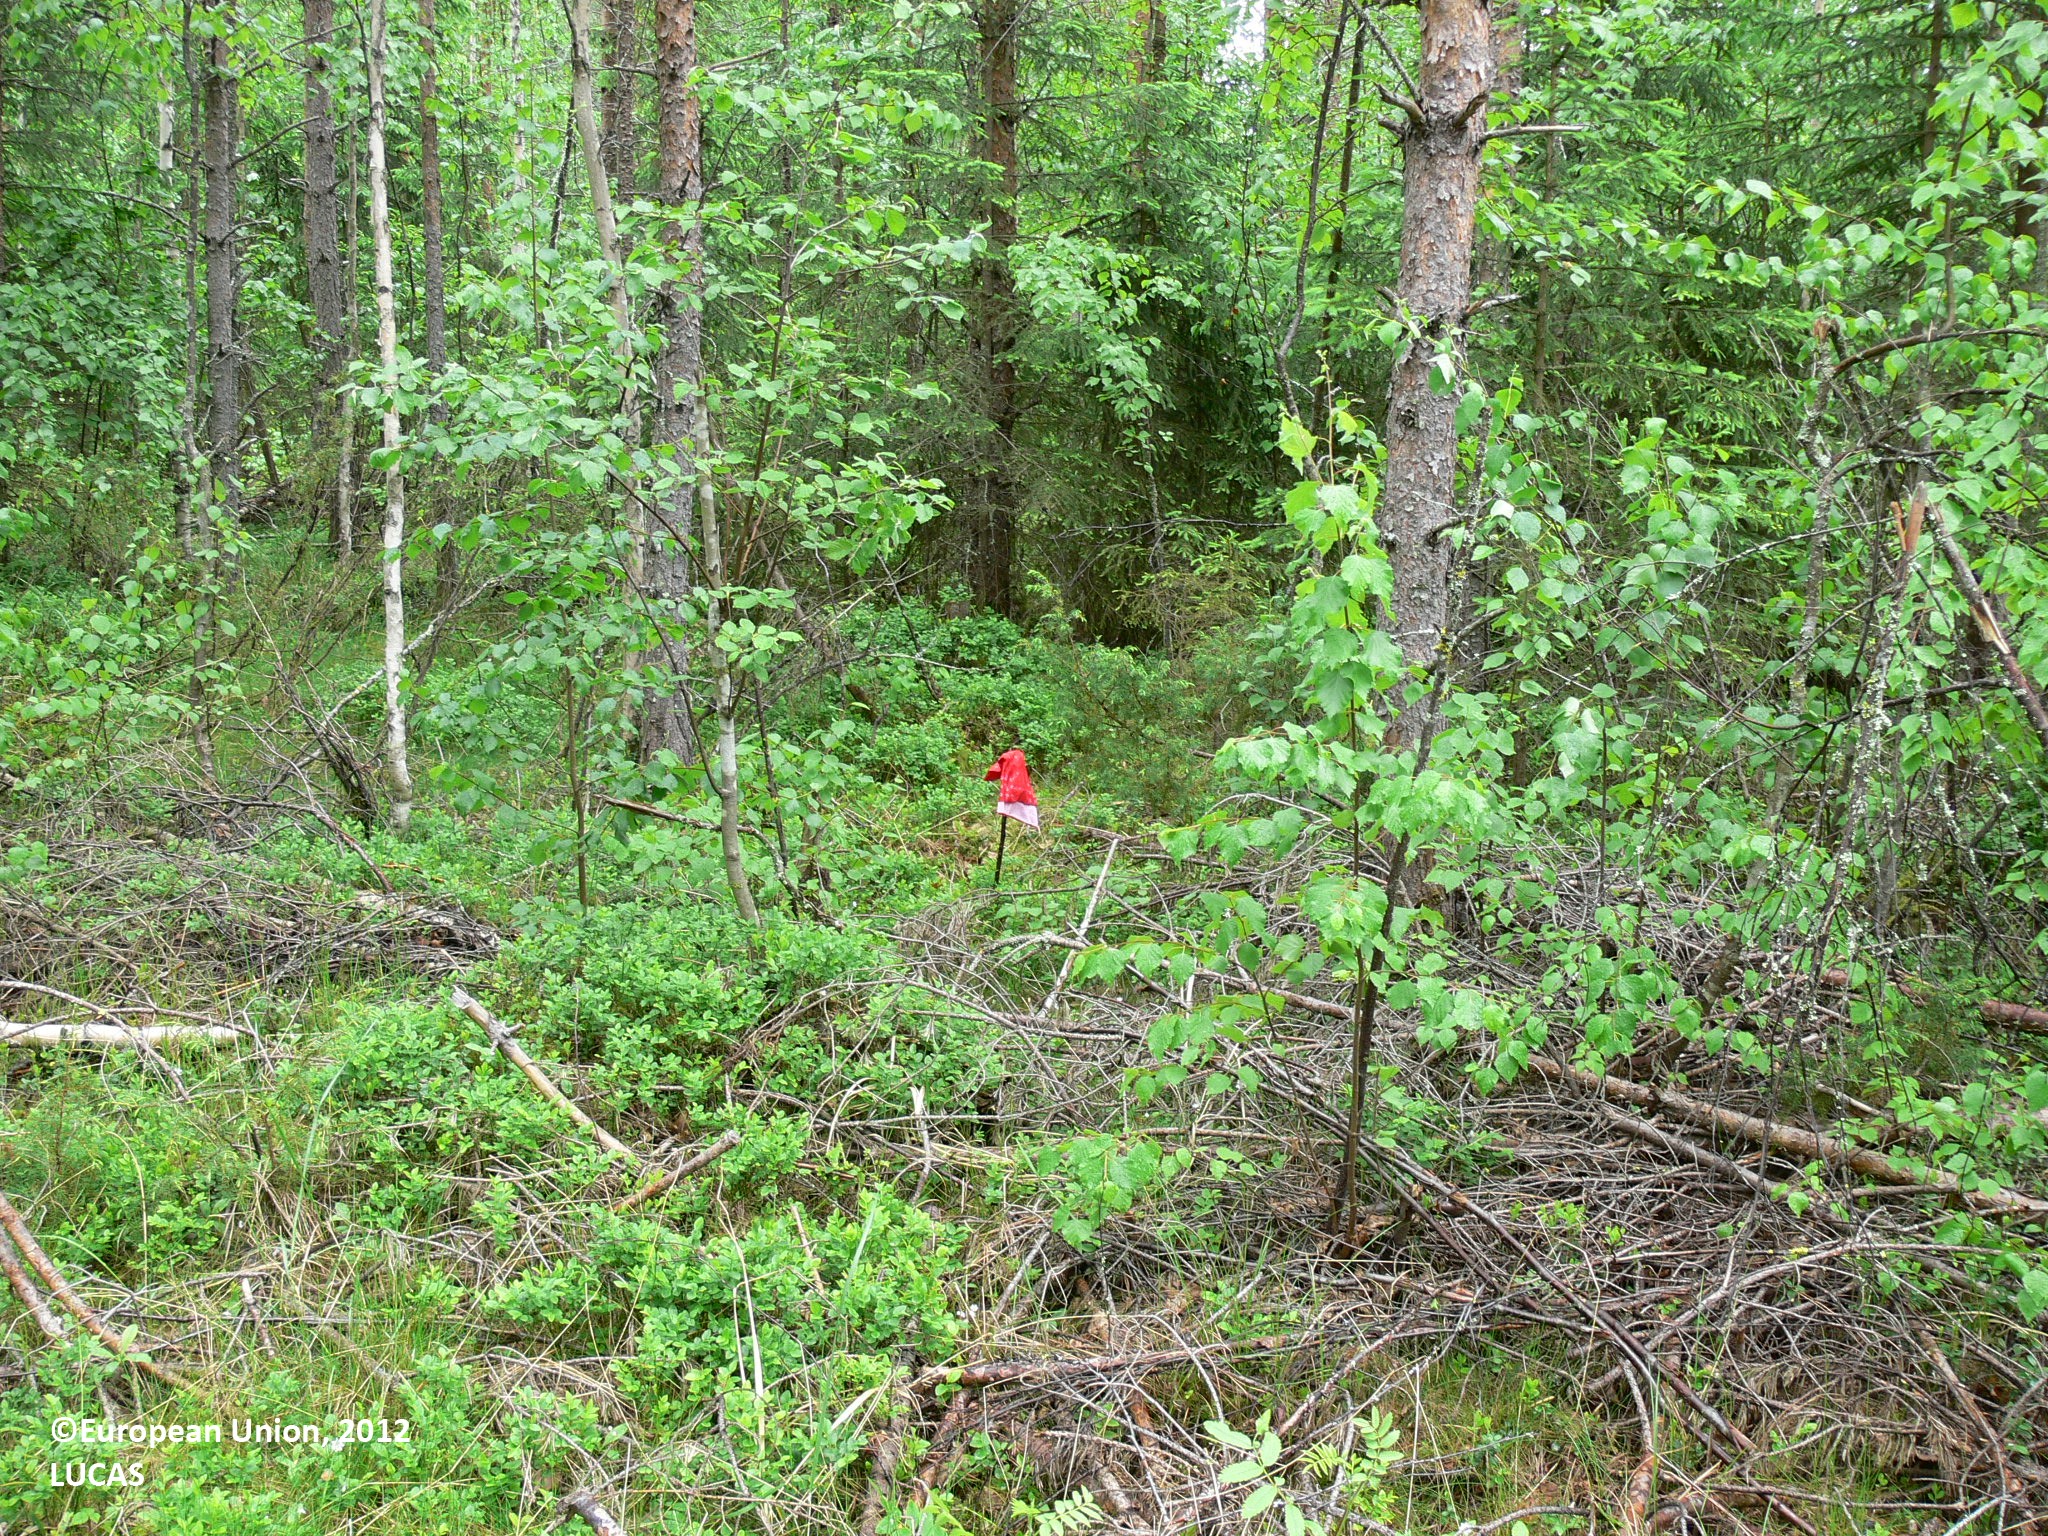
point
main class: Woodland
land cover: Pine dominated coniferous woodland
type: boreal forest
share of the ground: > 75 %
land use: Forestry
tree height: > 5 m
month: June
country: FI
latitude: 62.9319
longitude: 29.7247
